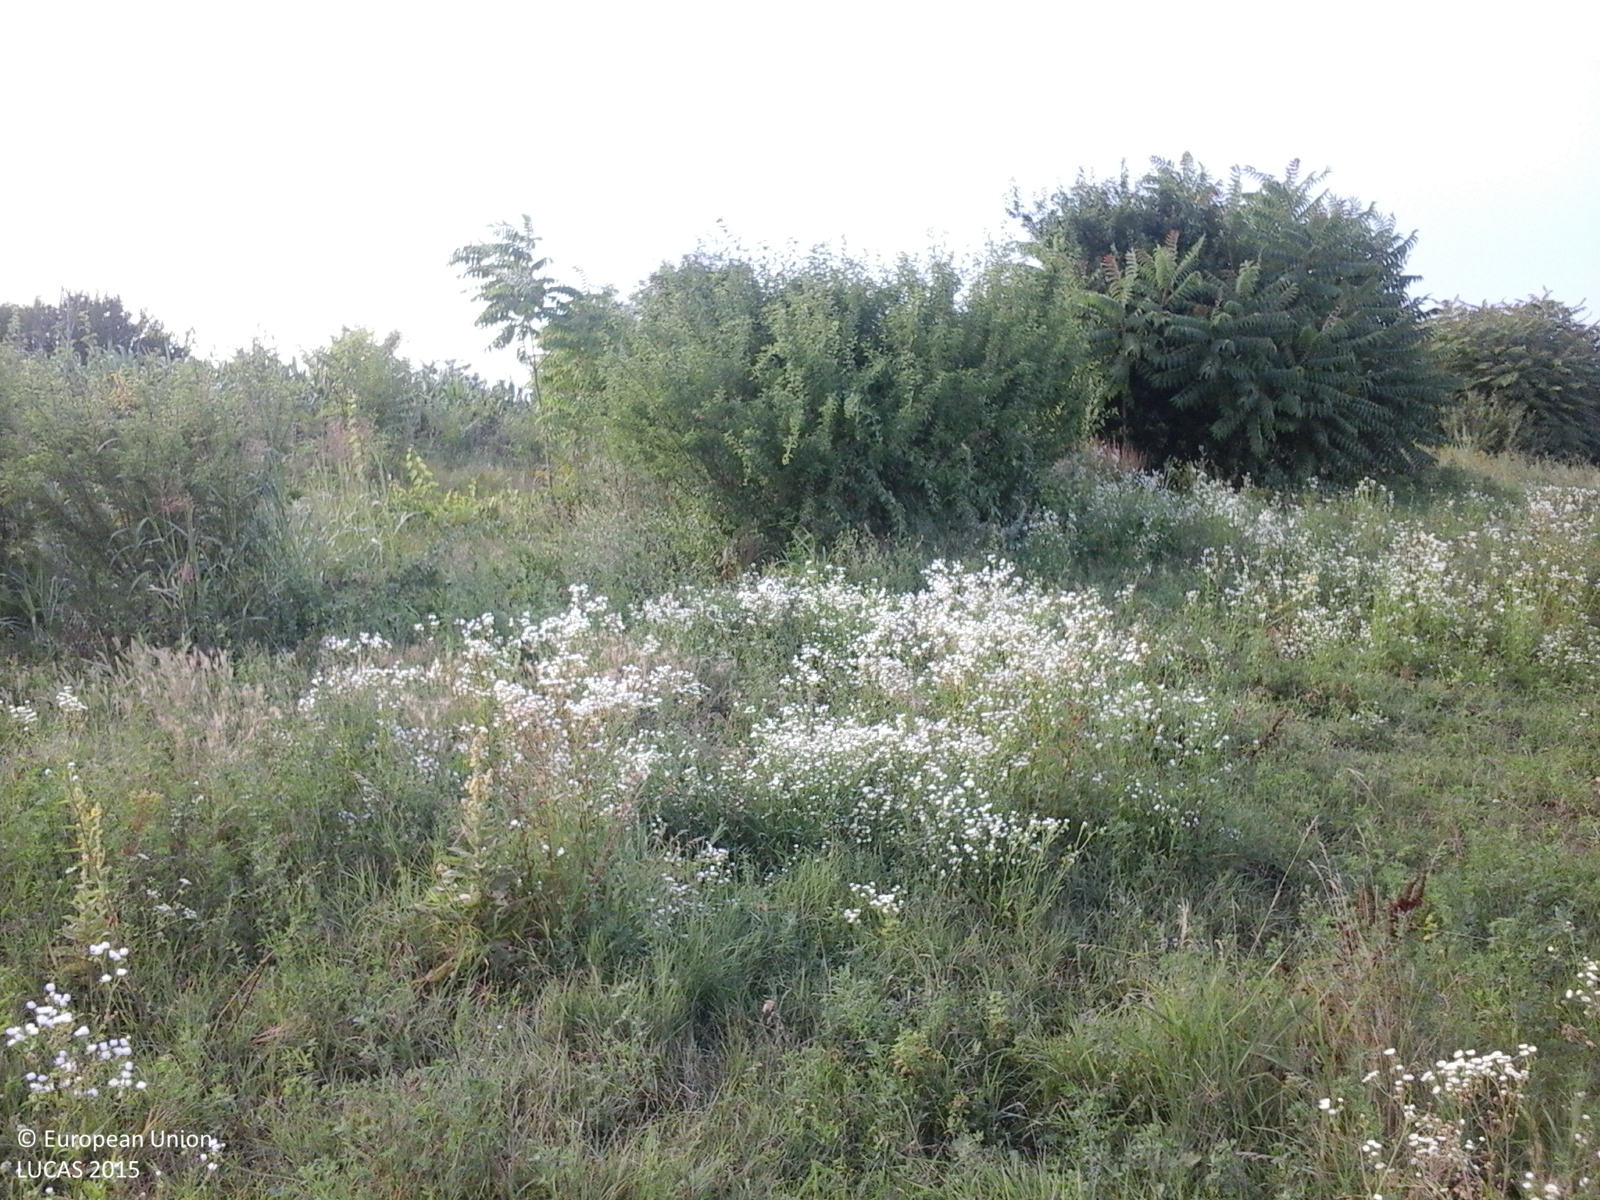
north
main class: Grassland
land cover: Spontaneously vegetated surfaces
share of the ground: > 75 %
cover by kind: herbaceous plants 100 %
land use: Agriculture (excluding fallow land and kitchen gardens)
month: July
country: RO
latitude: 44.1621
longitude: 24.4095
